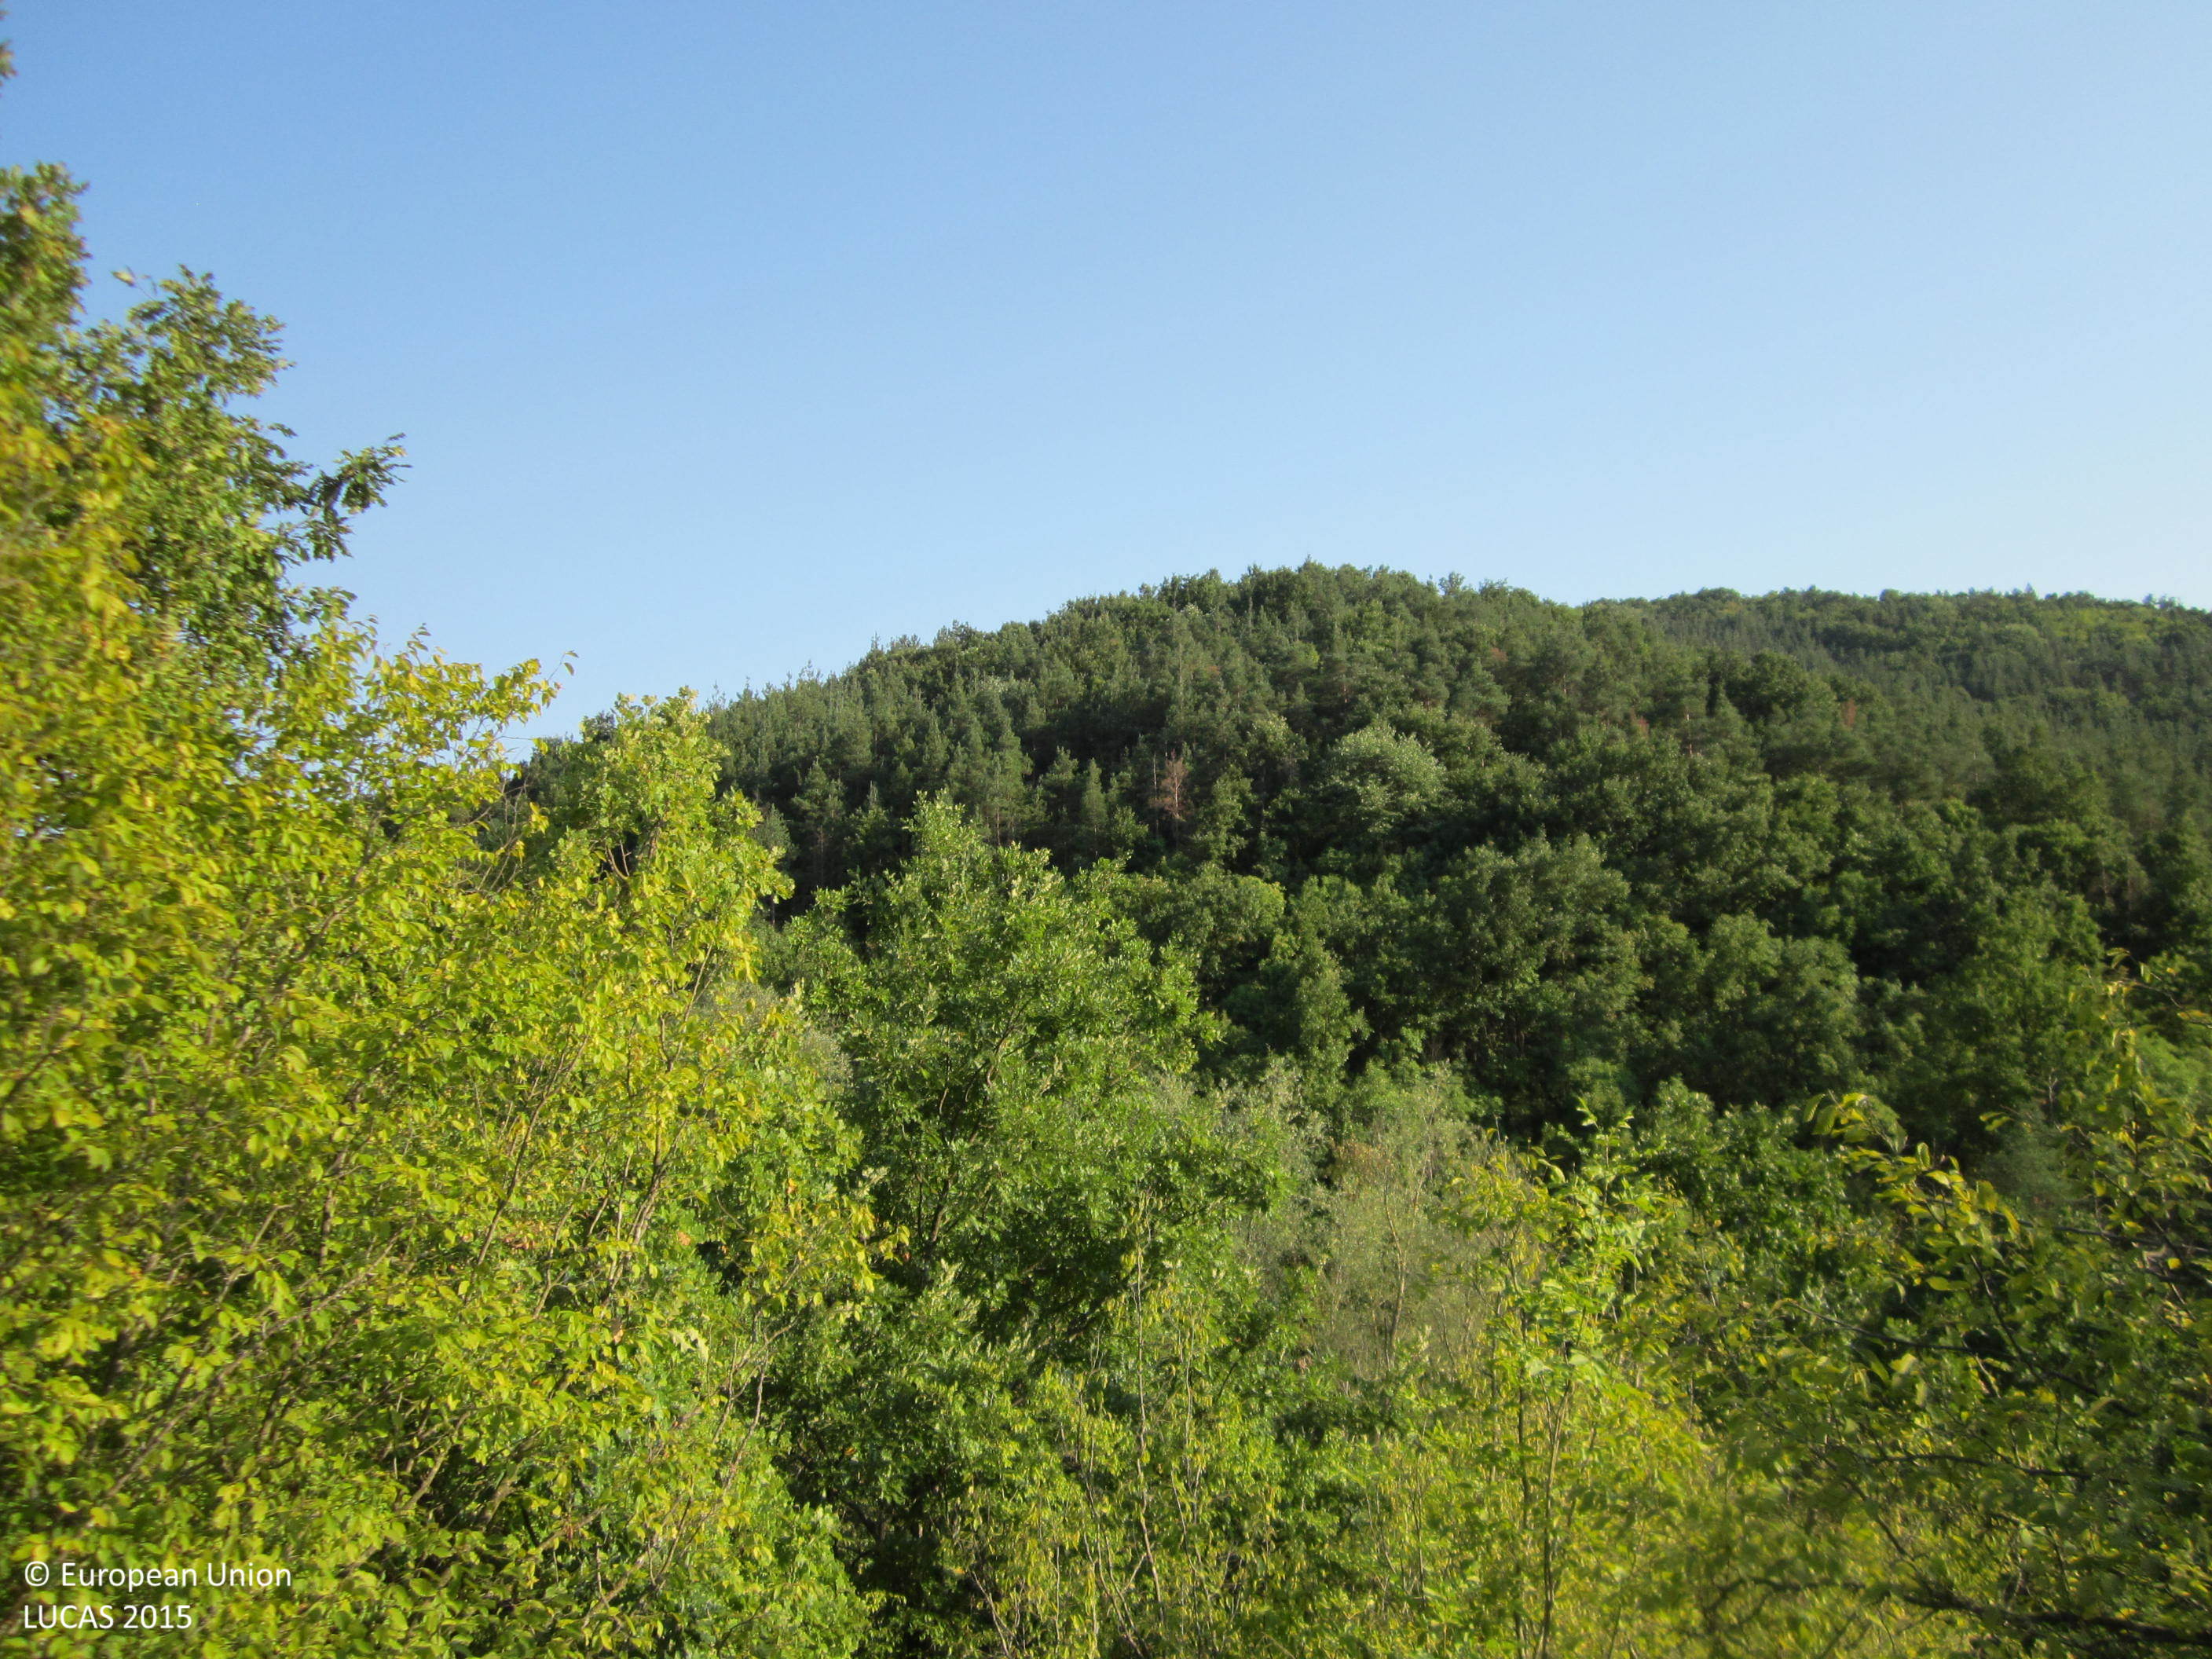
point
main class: Woodland
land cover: Broadleaved woodland
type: mesophytic deciduous forest
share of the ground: > 75 %
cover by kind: broadleaved forest trees 100 %
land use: Forestry
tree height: > 5 m
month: September
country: BG
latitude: 42.9011
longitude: 27.1999
